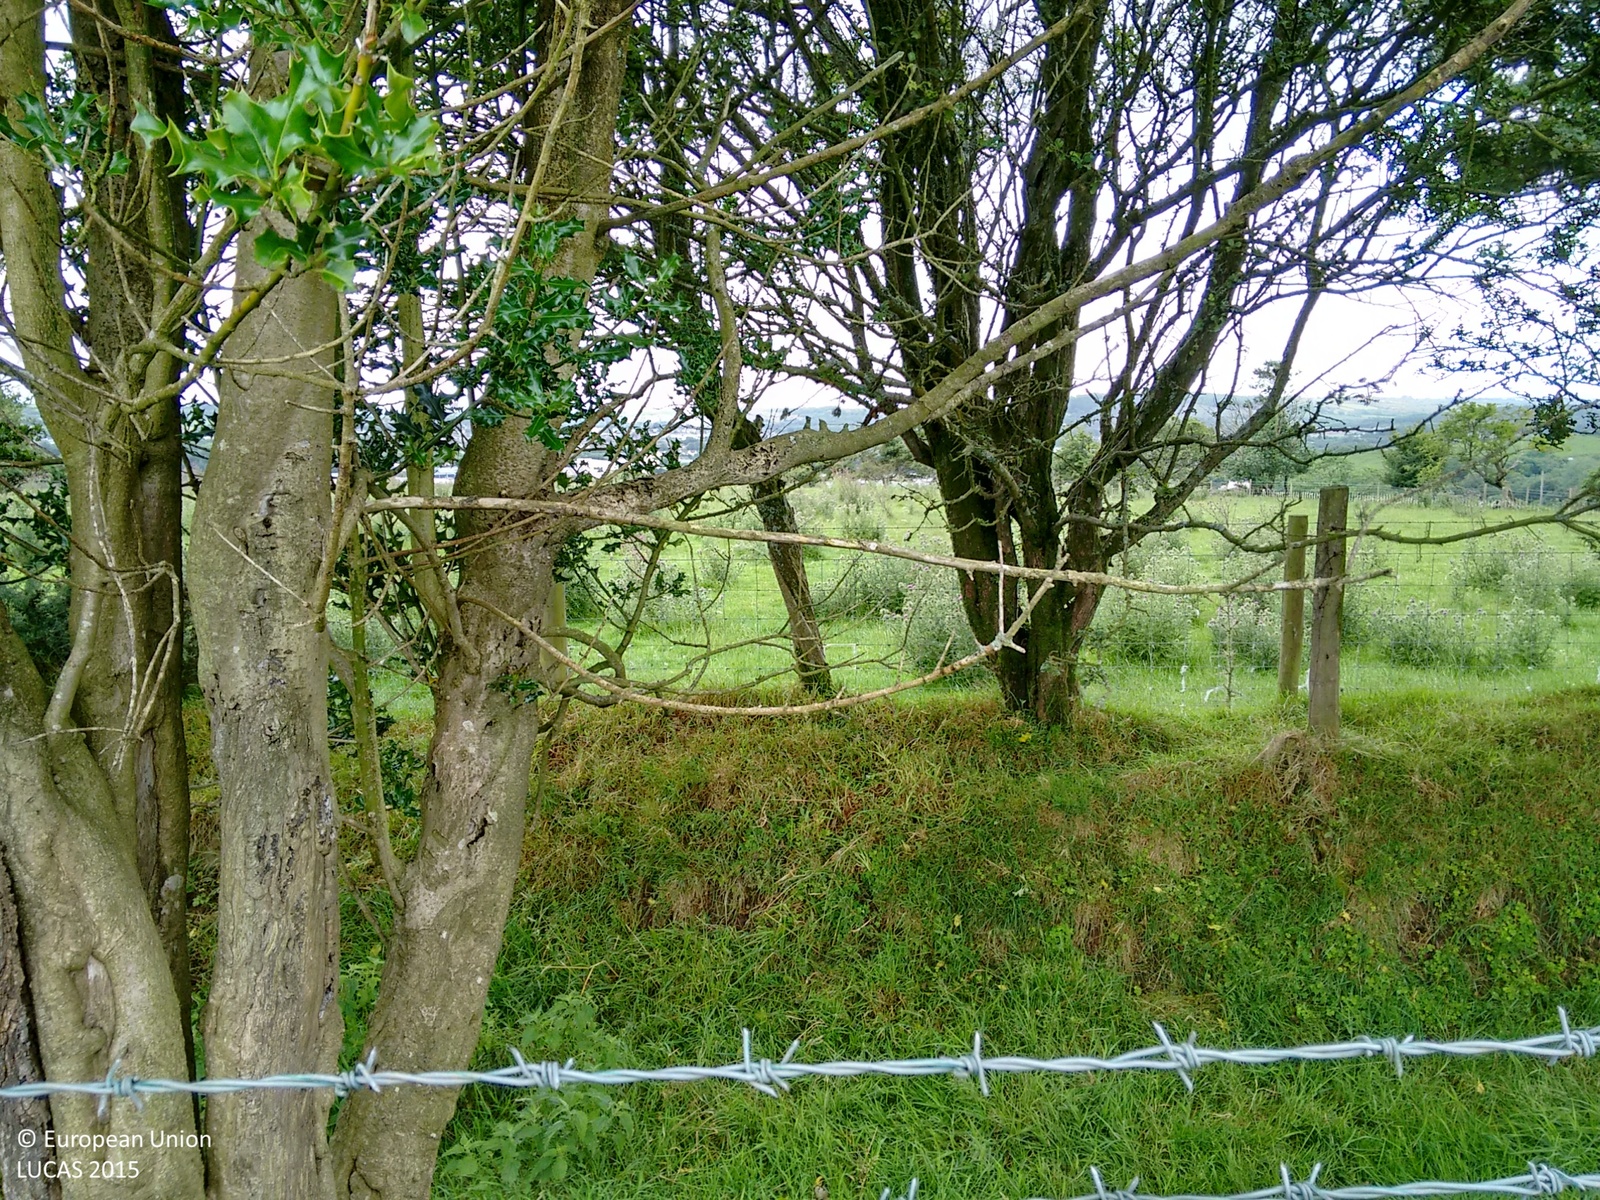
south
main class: Grassland
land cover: Grassland without tree/shrub cover
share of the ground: > 75 %
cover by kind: herbaceous plants 100 %
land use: Agriculture (excluding fallow land and kitchen gardens)
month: July
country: GB
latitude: 51.5568
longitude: -3.5718
